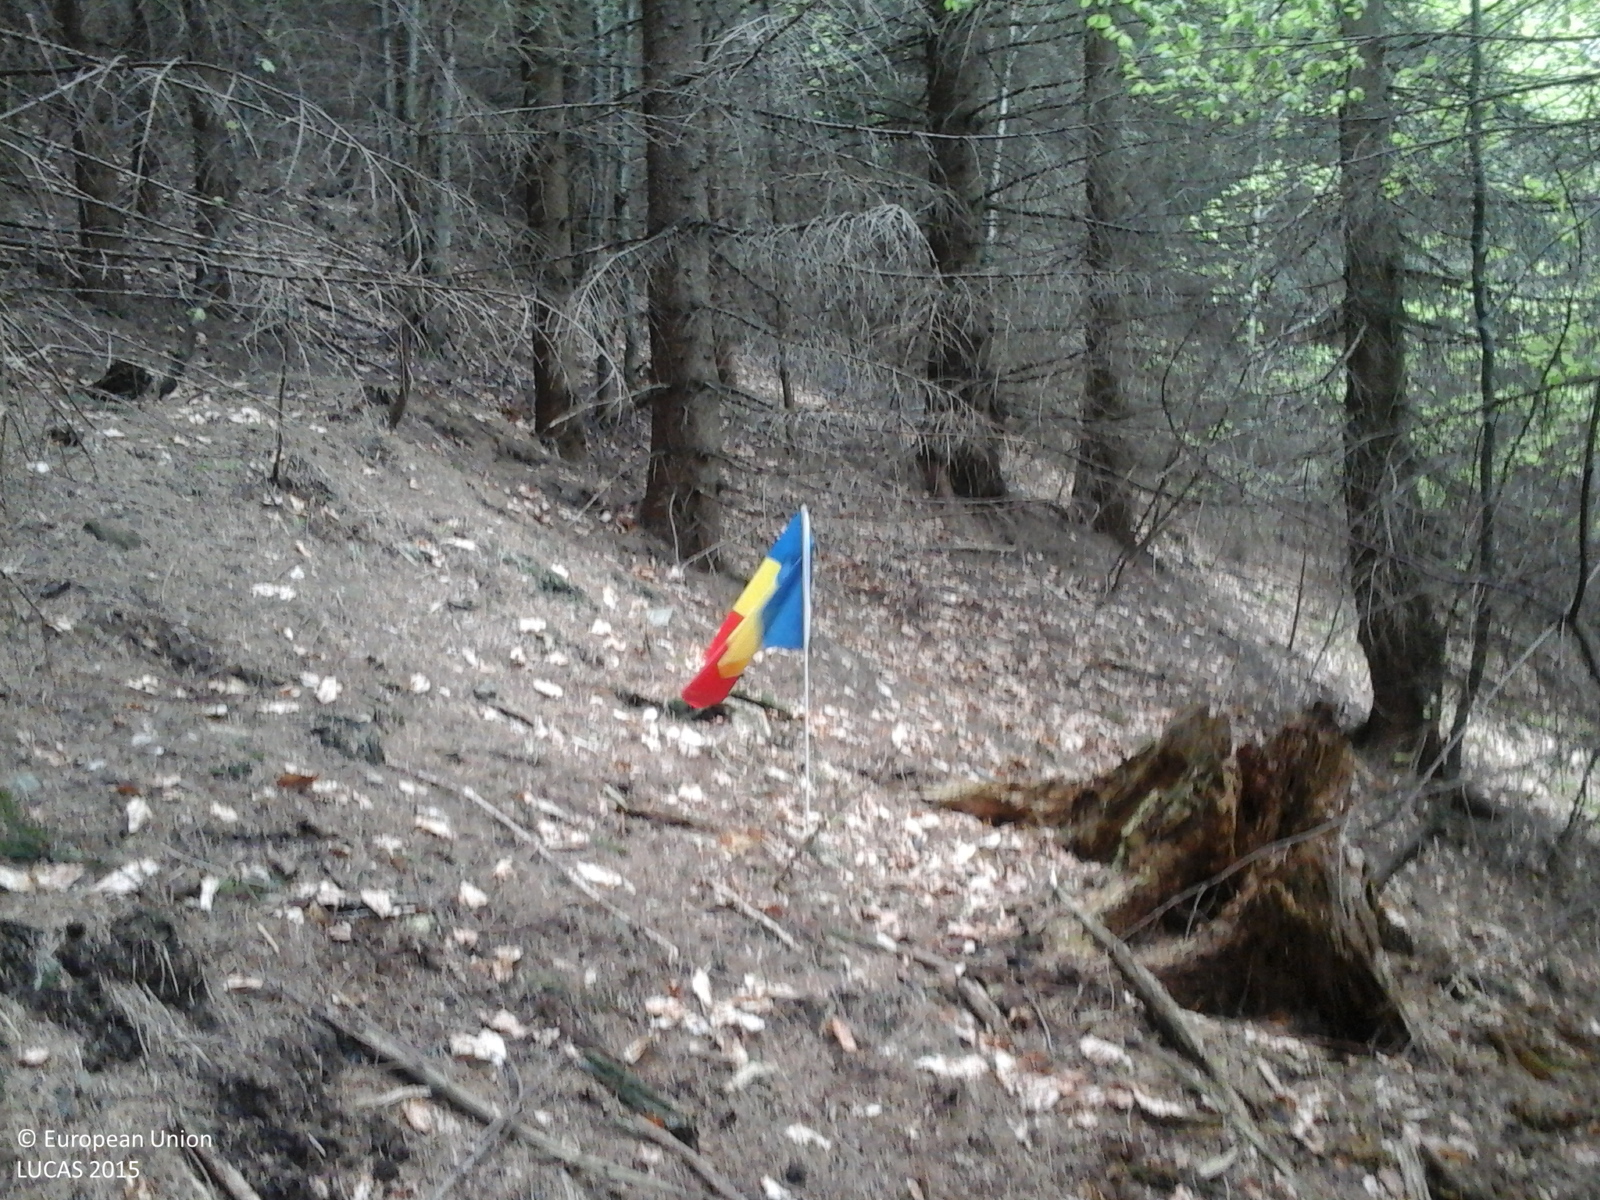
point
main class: Woodland
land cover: Spruce dominated mixed woodland
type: alpine coniferous forest
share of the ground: > 75 %
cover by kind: coniferous forest trees 75 %, broadleaved forest trees 25 %
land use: Forestry
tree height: > 5 m
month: May
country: RO
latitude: 45.7462
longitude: 26.3319
